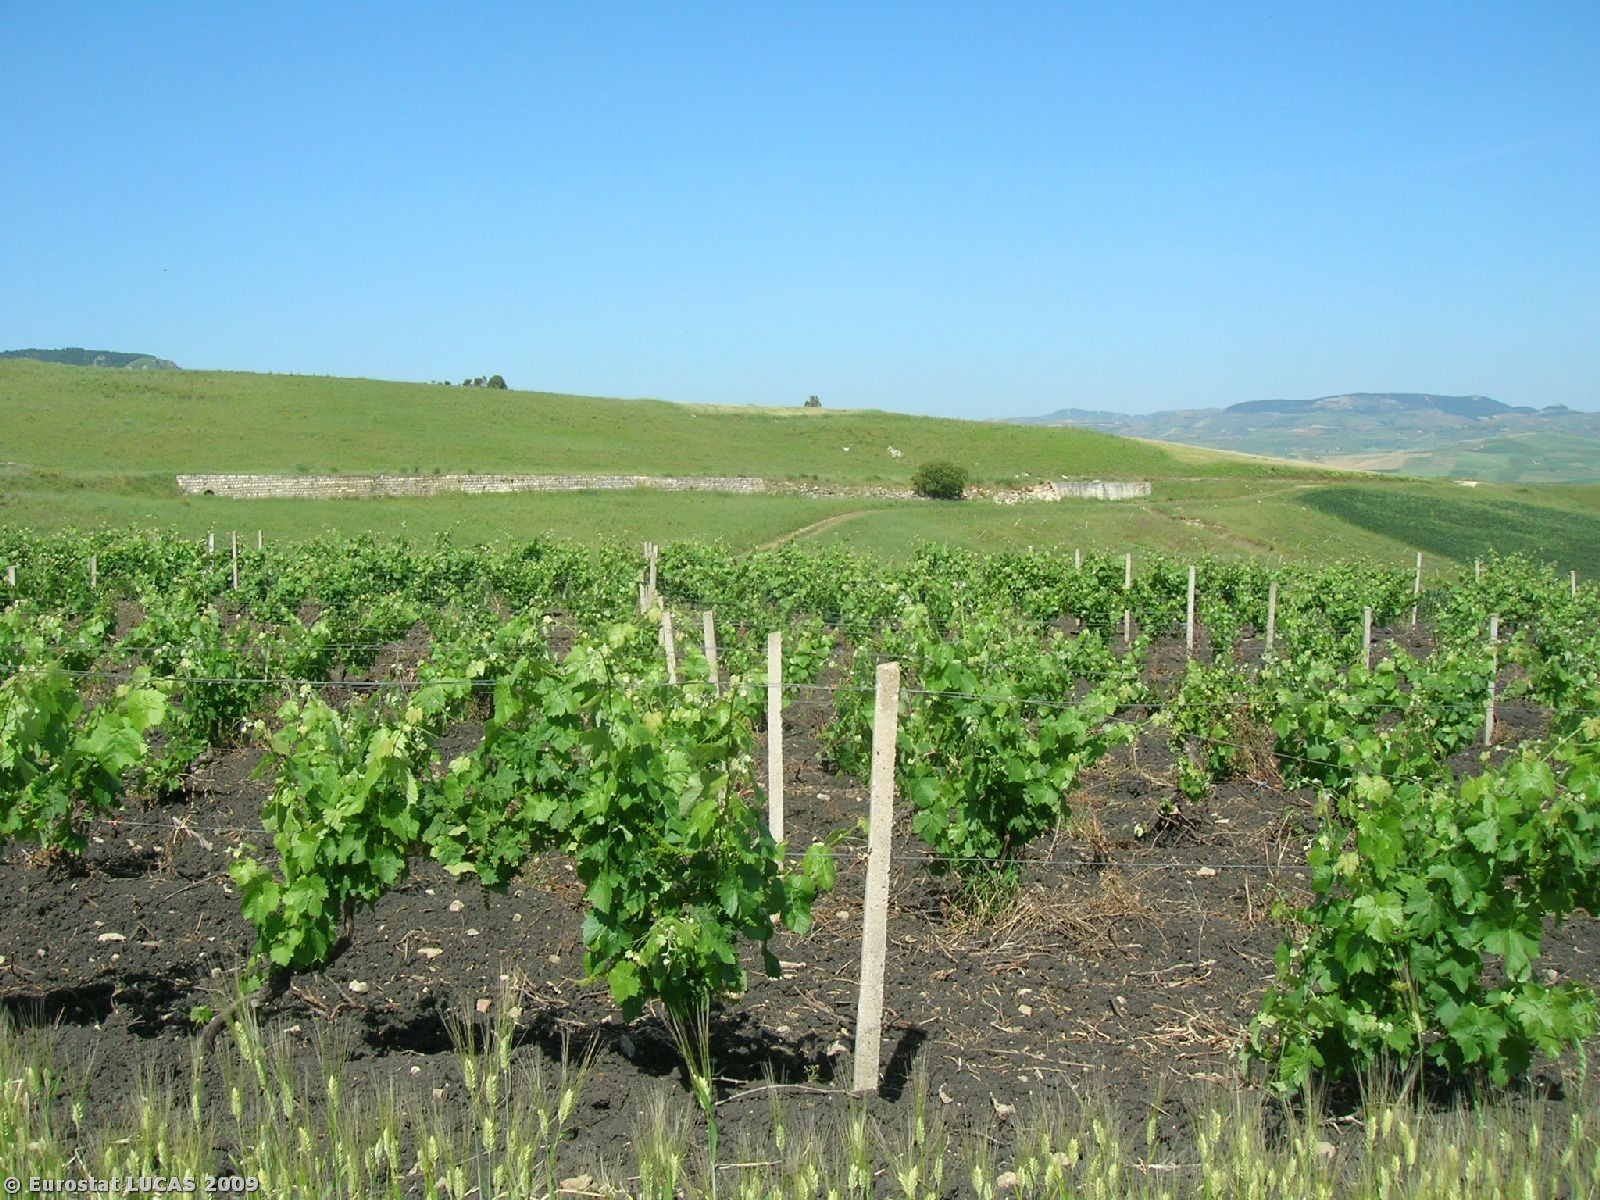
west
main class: Cropland
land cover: Durum wheat
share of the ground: > 75 %
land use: Agriculture (excluding fallow land and kitchen gardens)
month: May
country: IT
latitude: 37.8103
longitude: 12.9654
